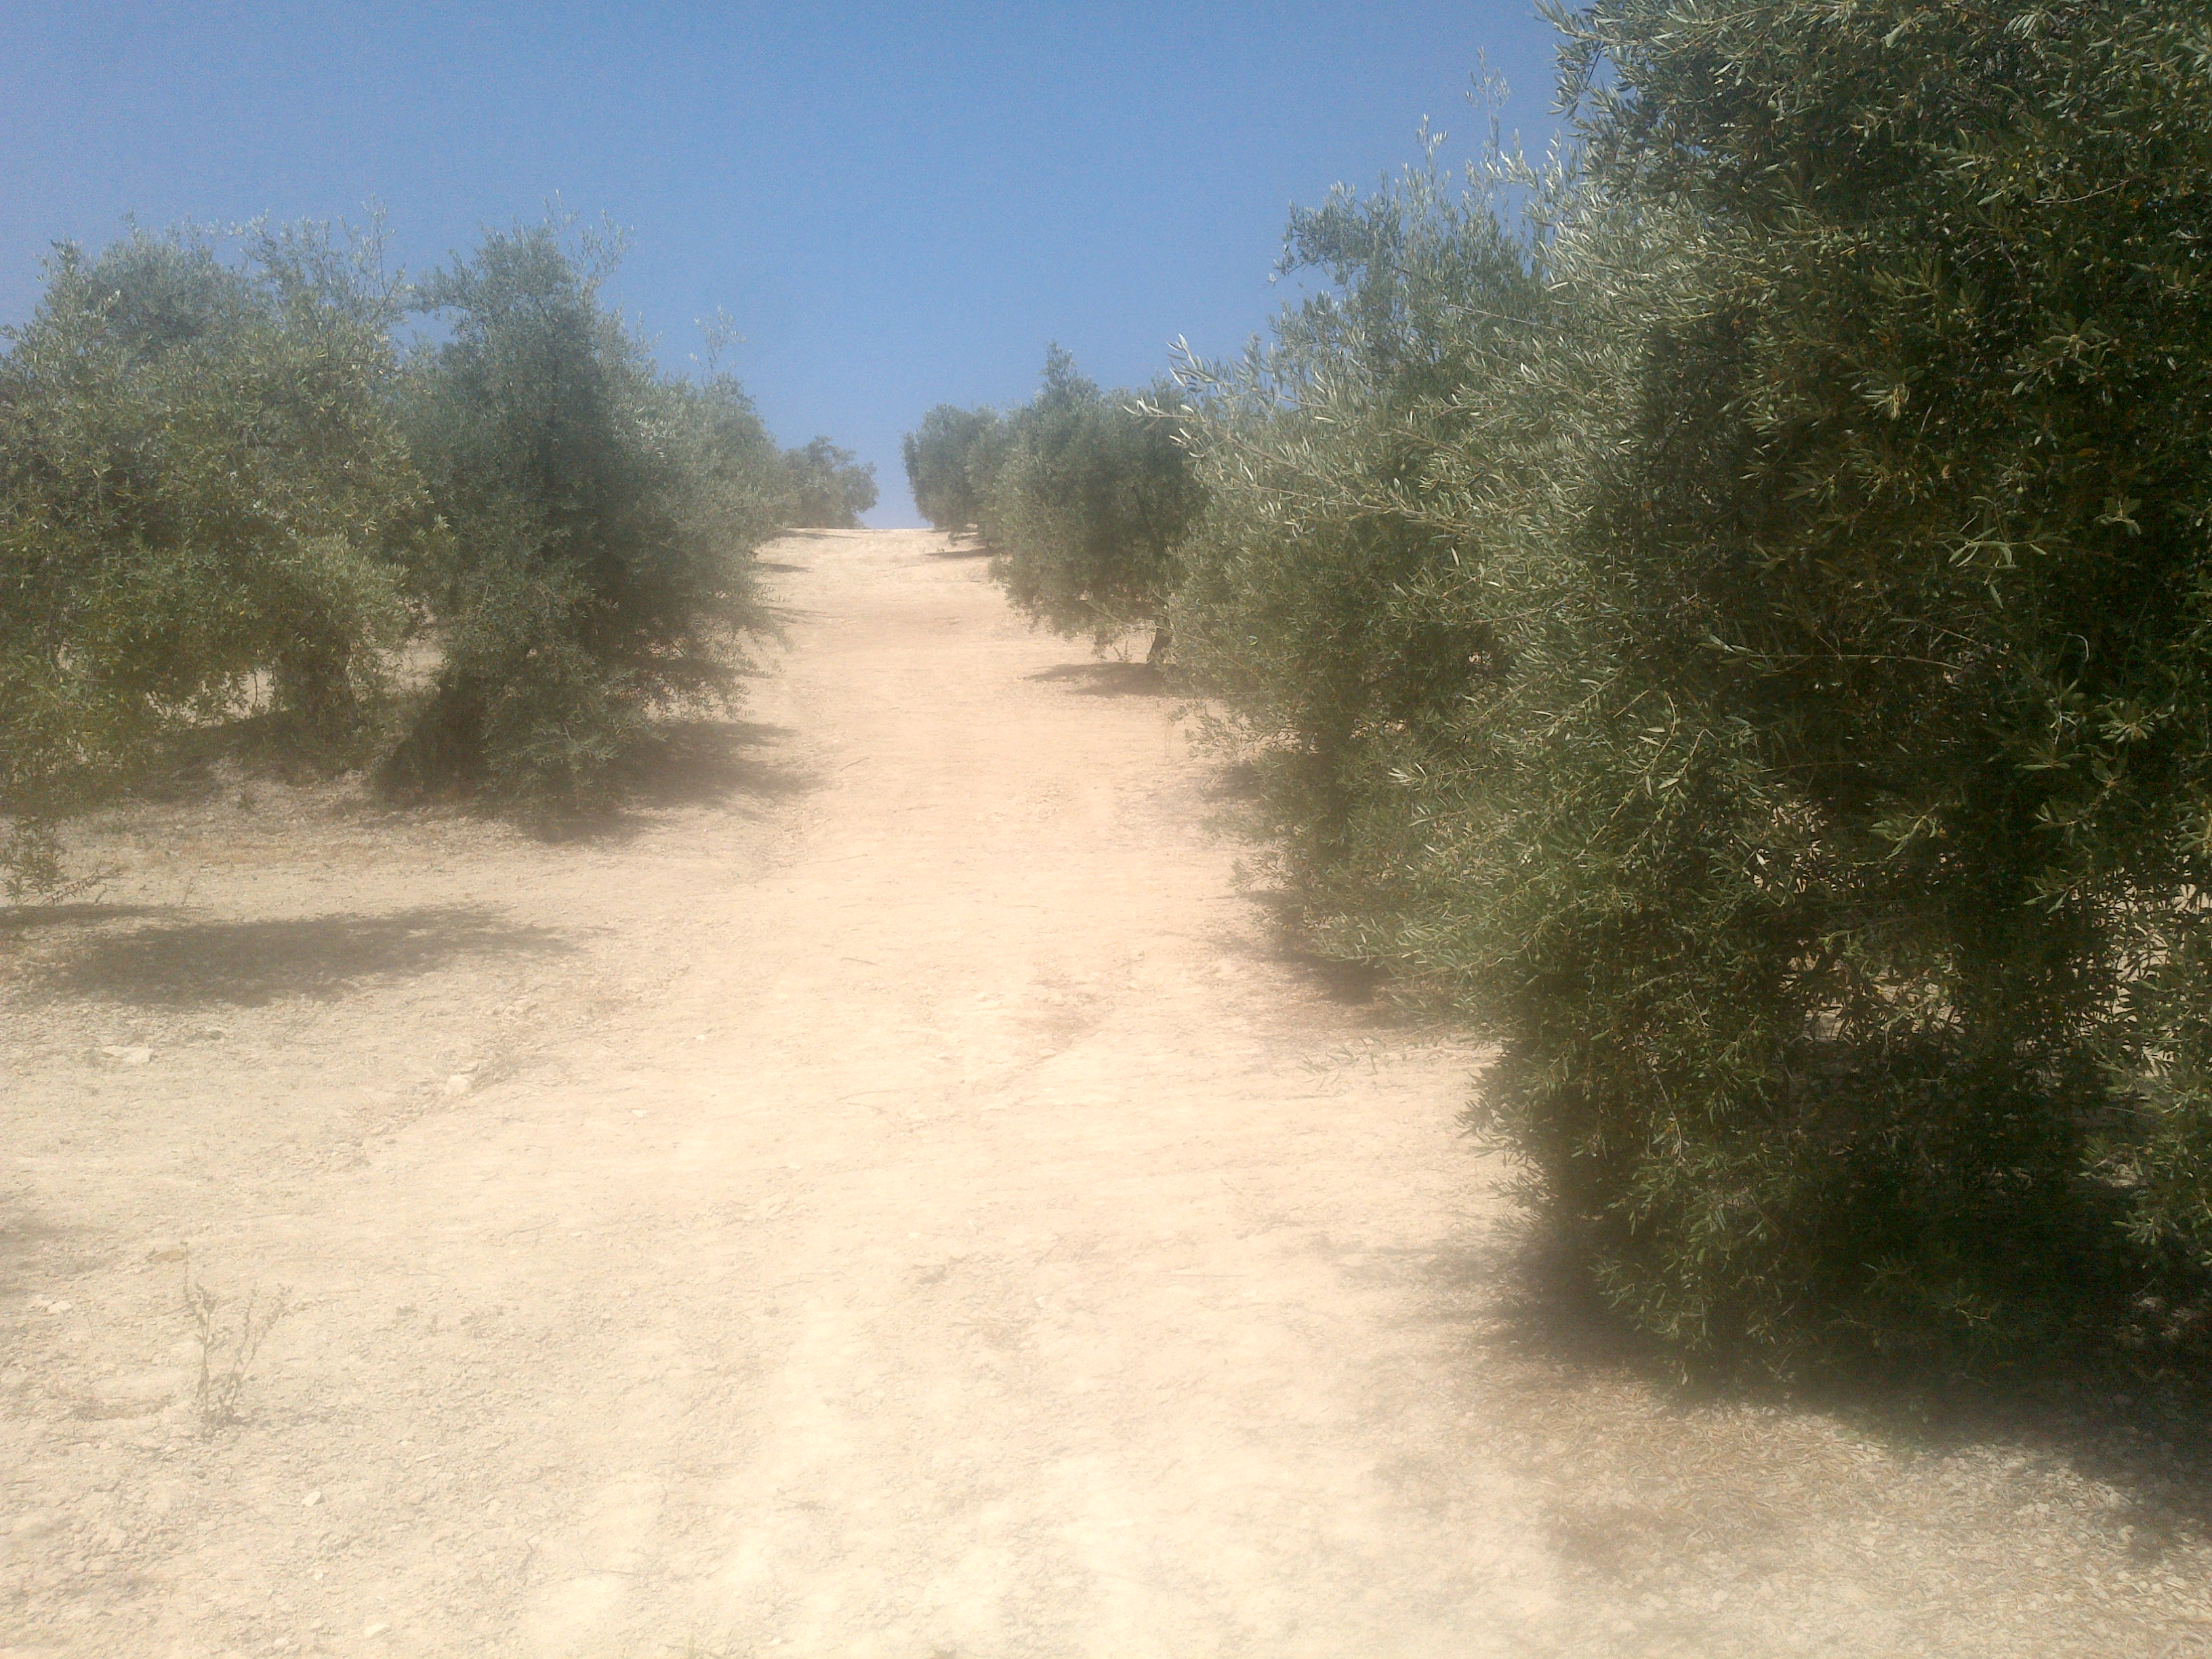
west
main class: Cropland
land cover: Olive groves
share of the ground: 50 - 75 %
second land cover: Other bare soil
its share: > 75 %
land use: Agriculture (excluding fallow land and kitchen gardens)
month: July
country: ES
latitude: 37.5409
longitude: -4.4343
